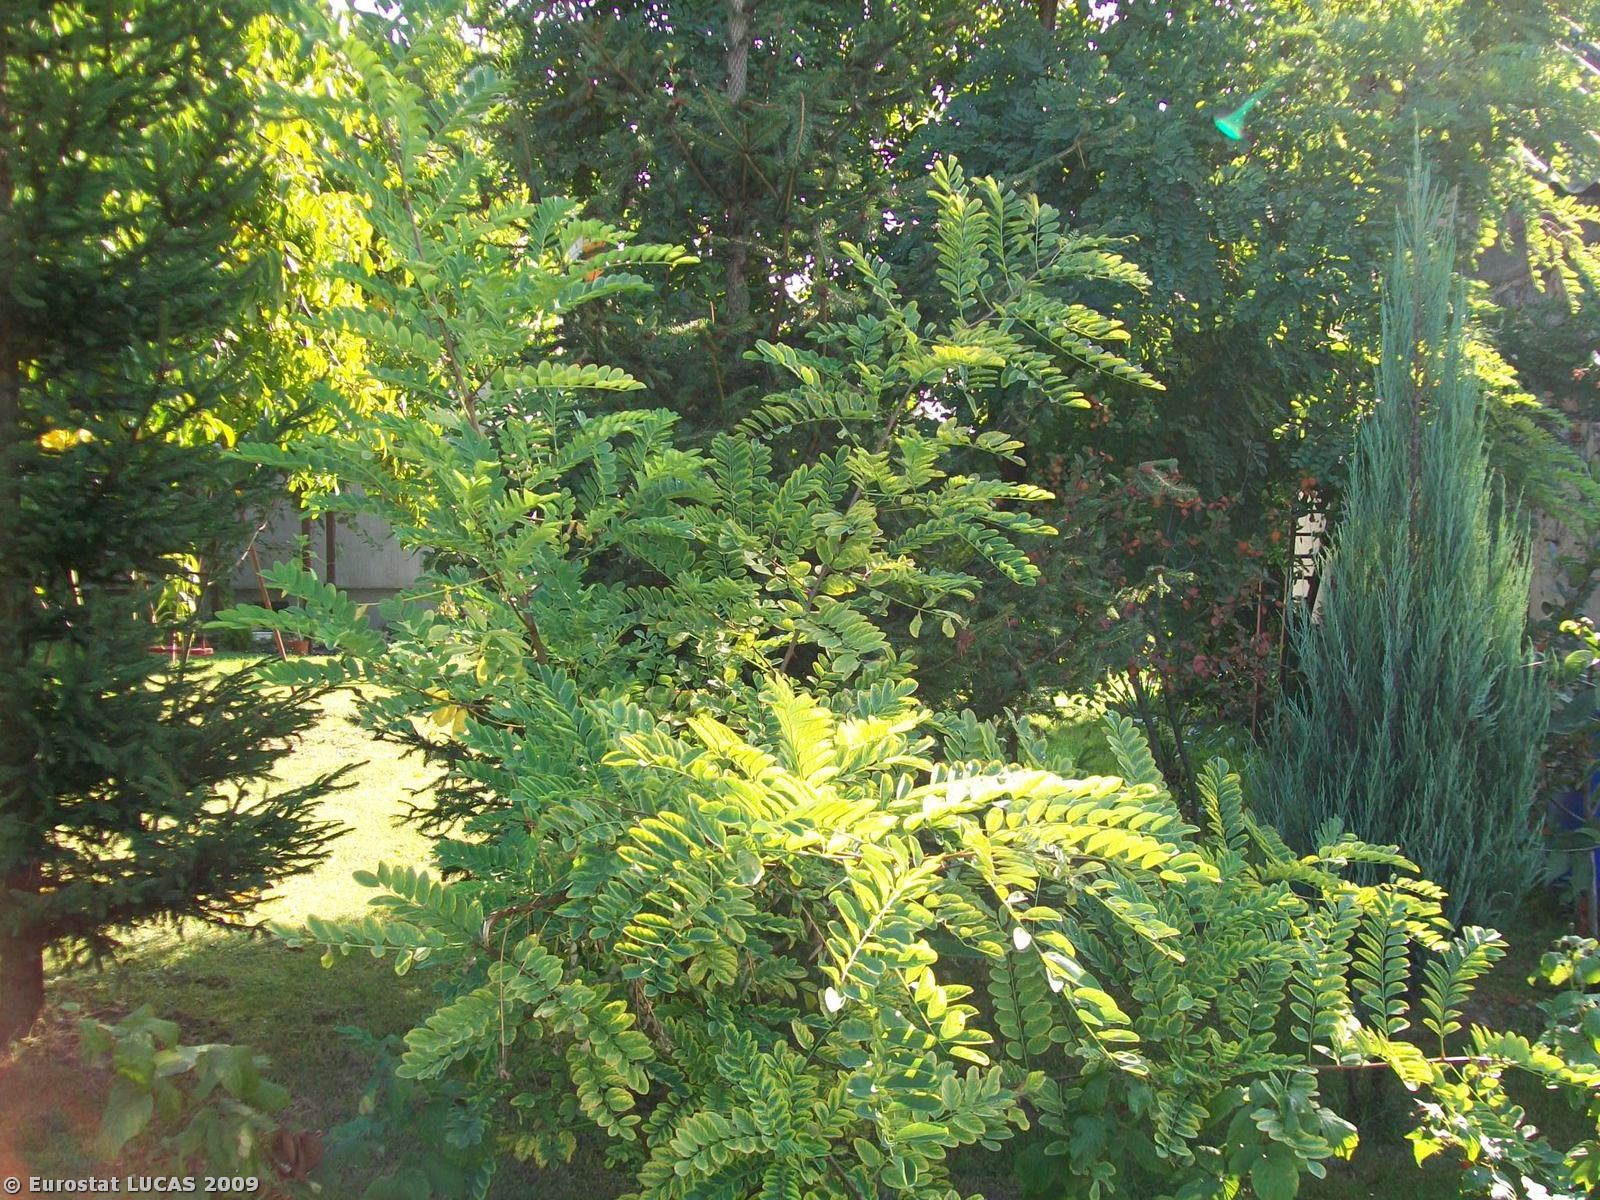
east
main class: Cropland
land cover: Strawberries
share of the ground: 25 - 50 %
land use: Kitchen garden
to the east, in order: Strawberries; Artificial constructions in urban areas; Ditches and canals; Grass margins; Electric lines; Paved roads, cycling and walking lanes
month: September
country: PL
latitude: 50.4614
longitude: 17.2094
